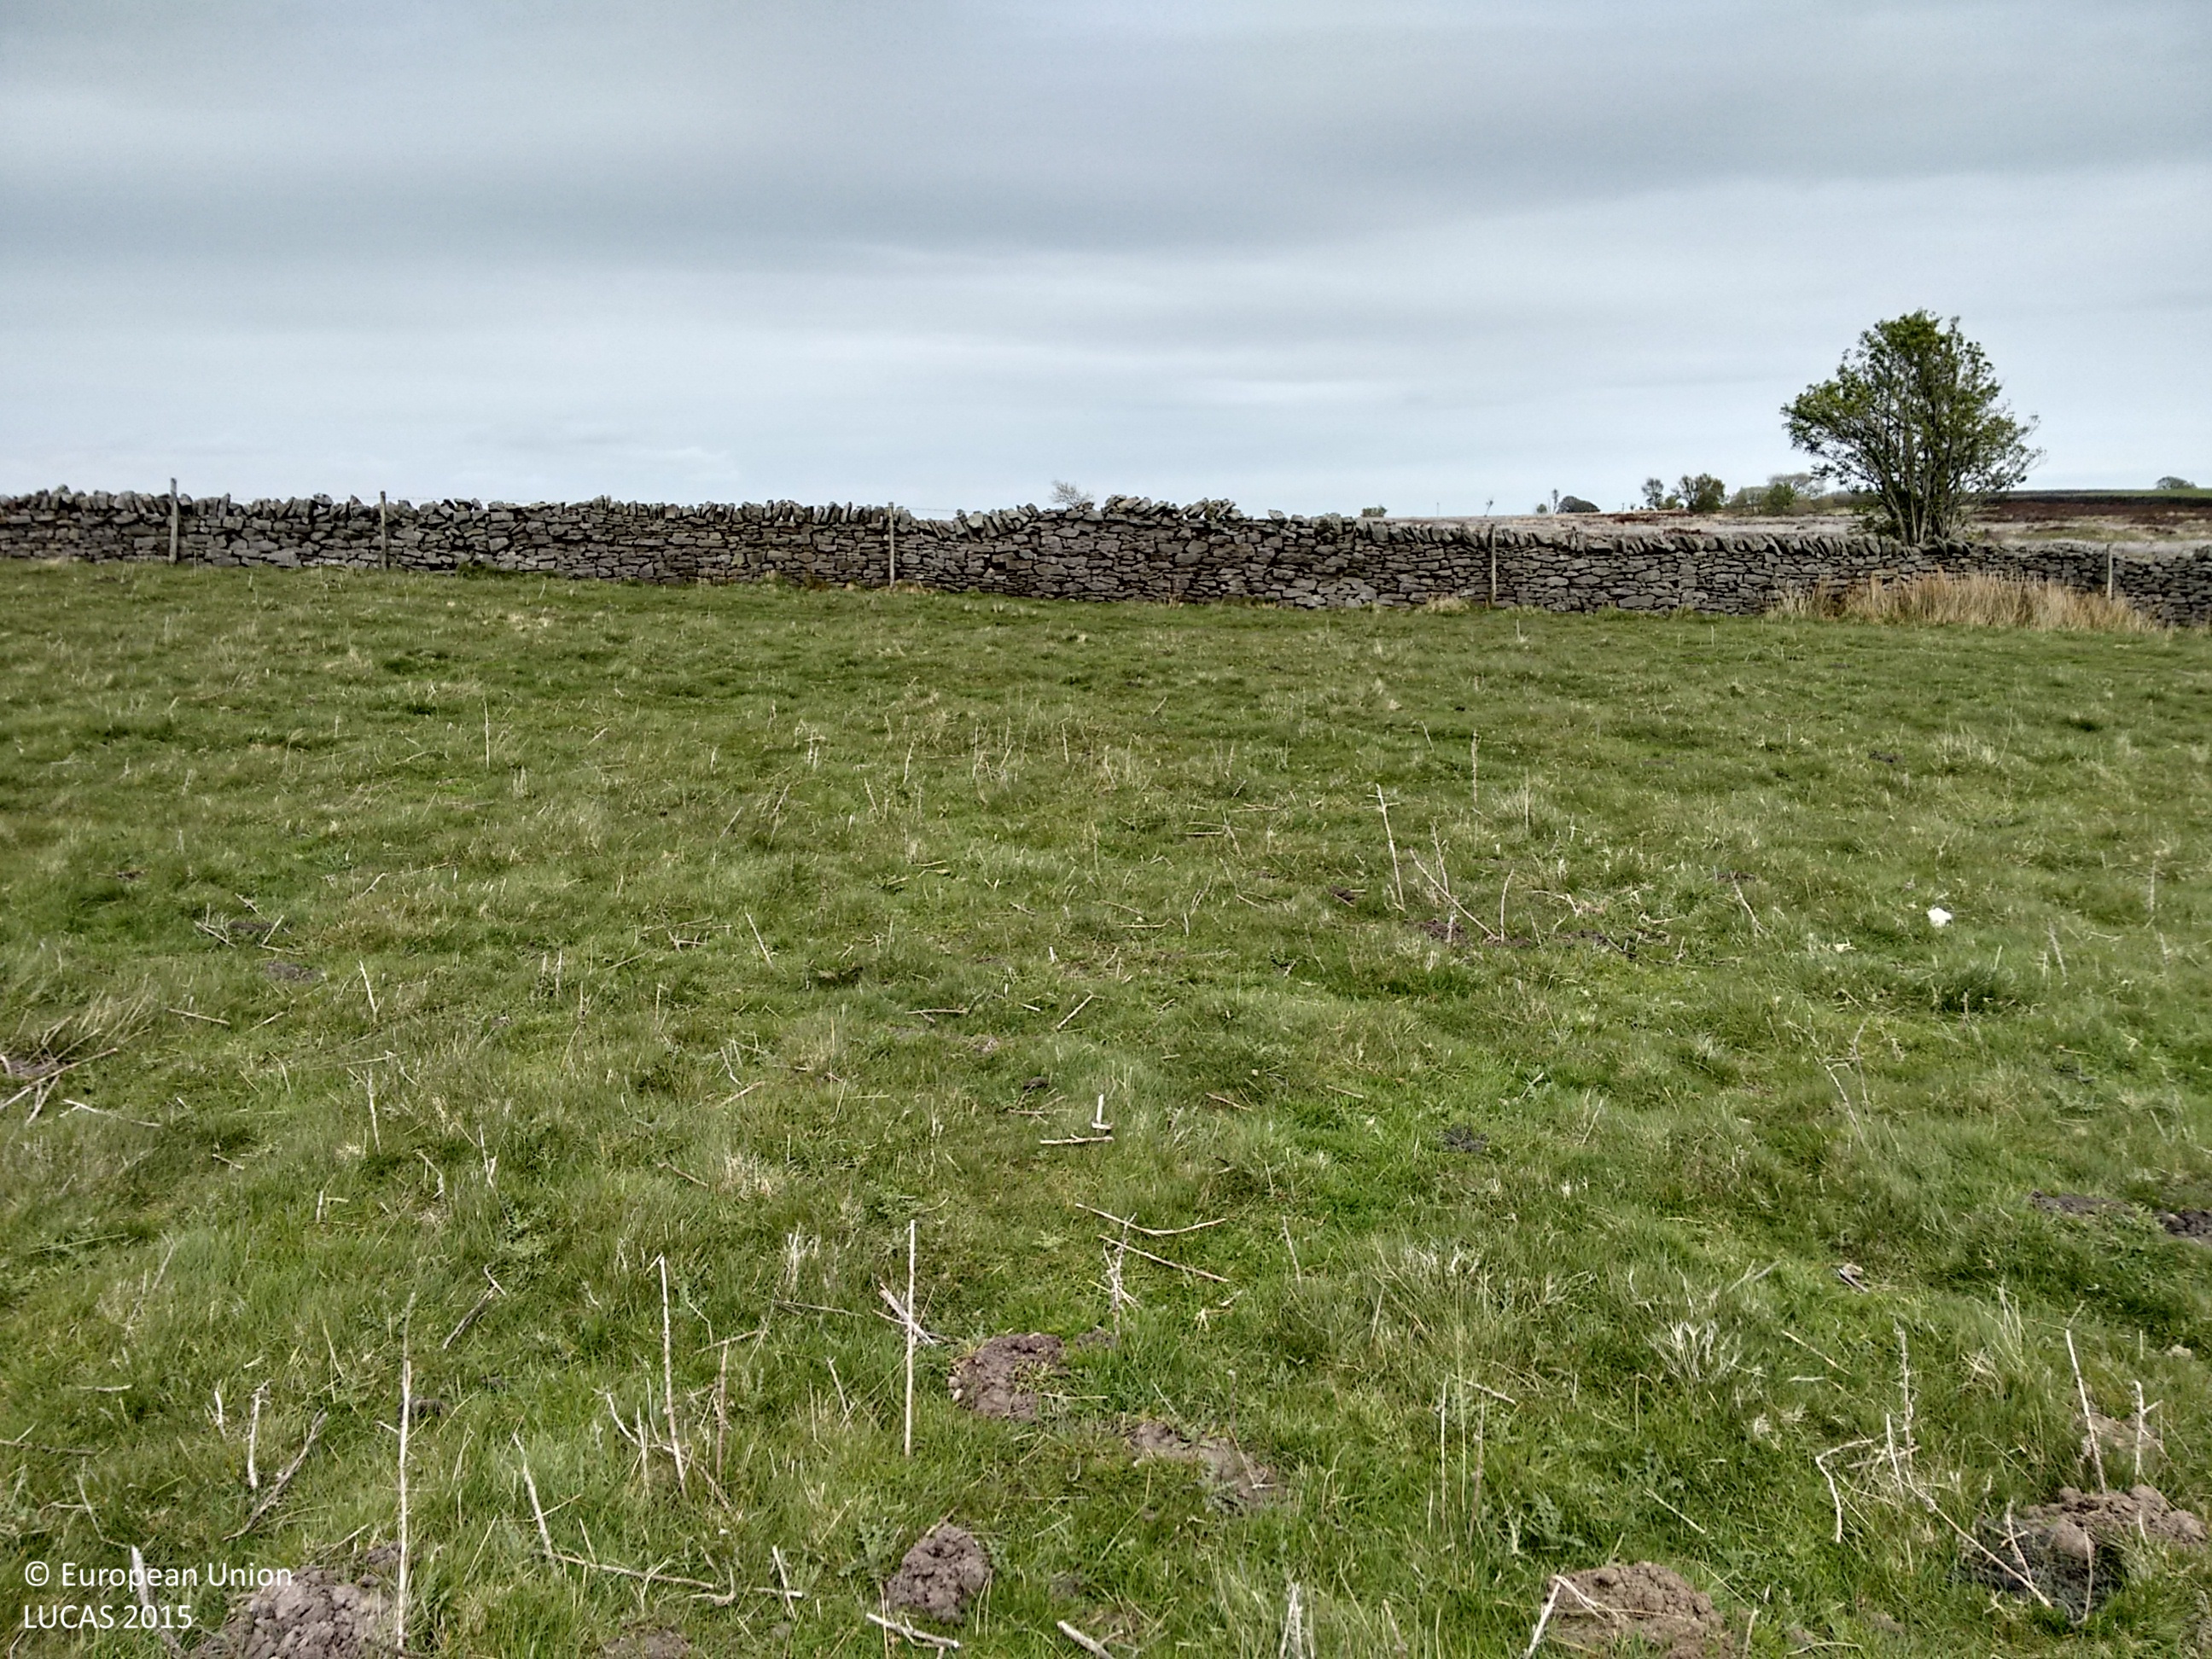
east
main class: Grassland
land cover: Grassland without tree/shrub cover
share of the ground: > 75 %
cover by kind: herbaceous plants 100 %
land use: Agriculture (excluding fallow land and kitchen gardens)
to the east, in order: Grassland without tree/shrub cover; Fences; Dry stone walls; Shrubland without tree cover
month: May
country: GB
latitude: 54.9427
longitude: -2.2506
